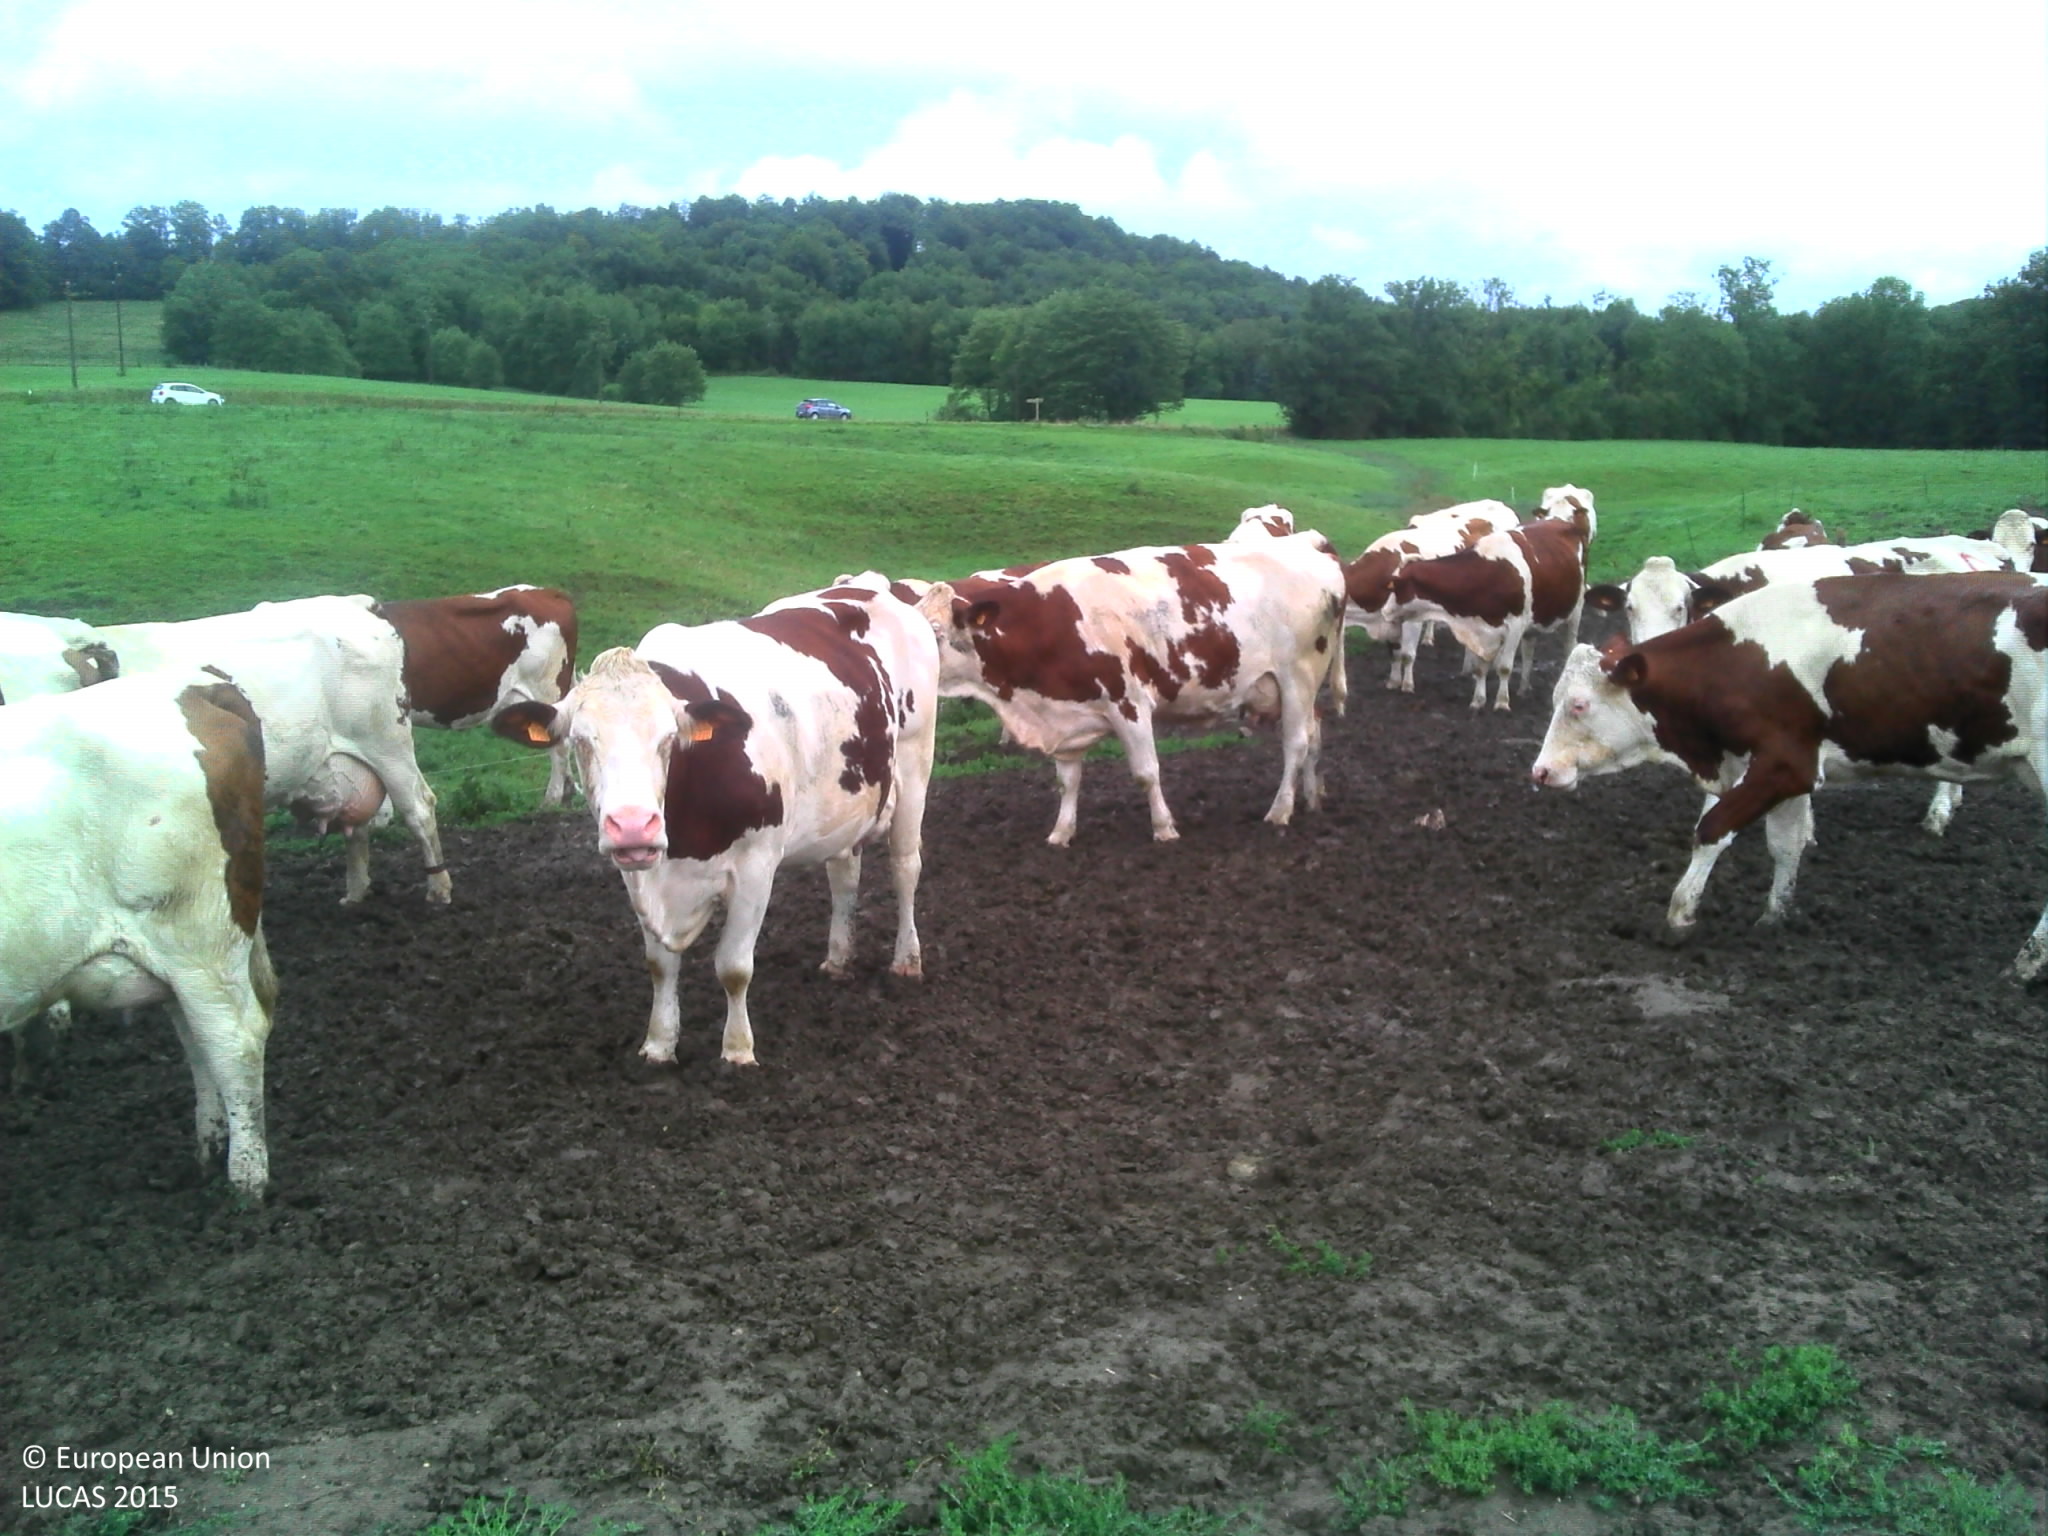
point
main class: Grassland
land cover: Grassland without tree/shrub cover
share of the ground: > 75 %
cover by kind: herbaceous plants 80 %, unconsolidated bare surface 20 %
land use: Agriculture (excluding fallow land and kitchen gardens)
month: September
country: FR
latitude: 47.1818
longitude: 6.1091
